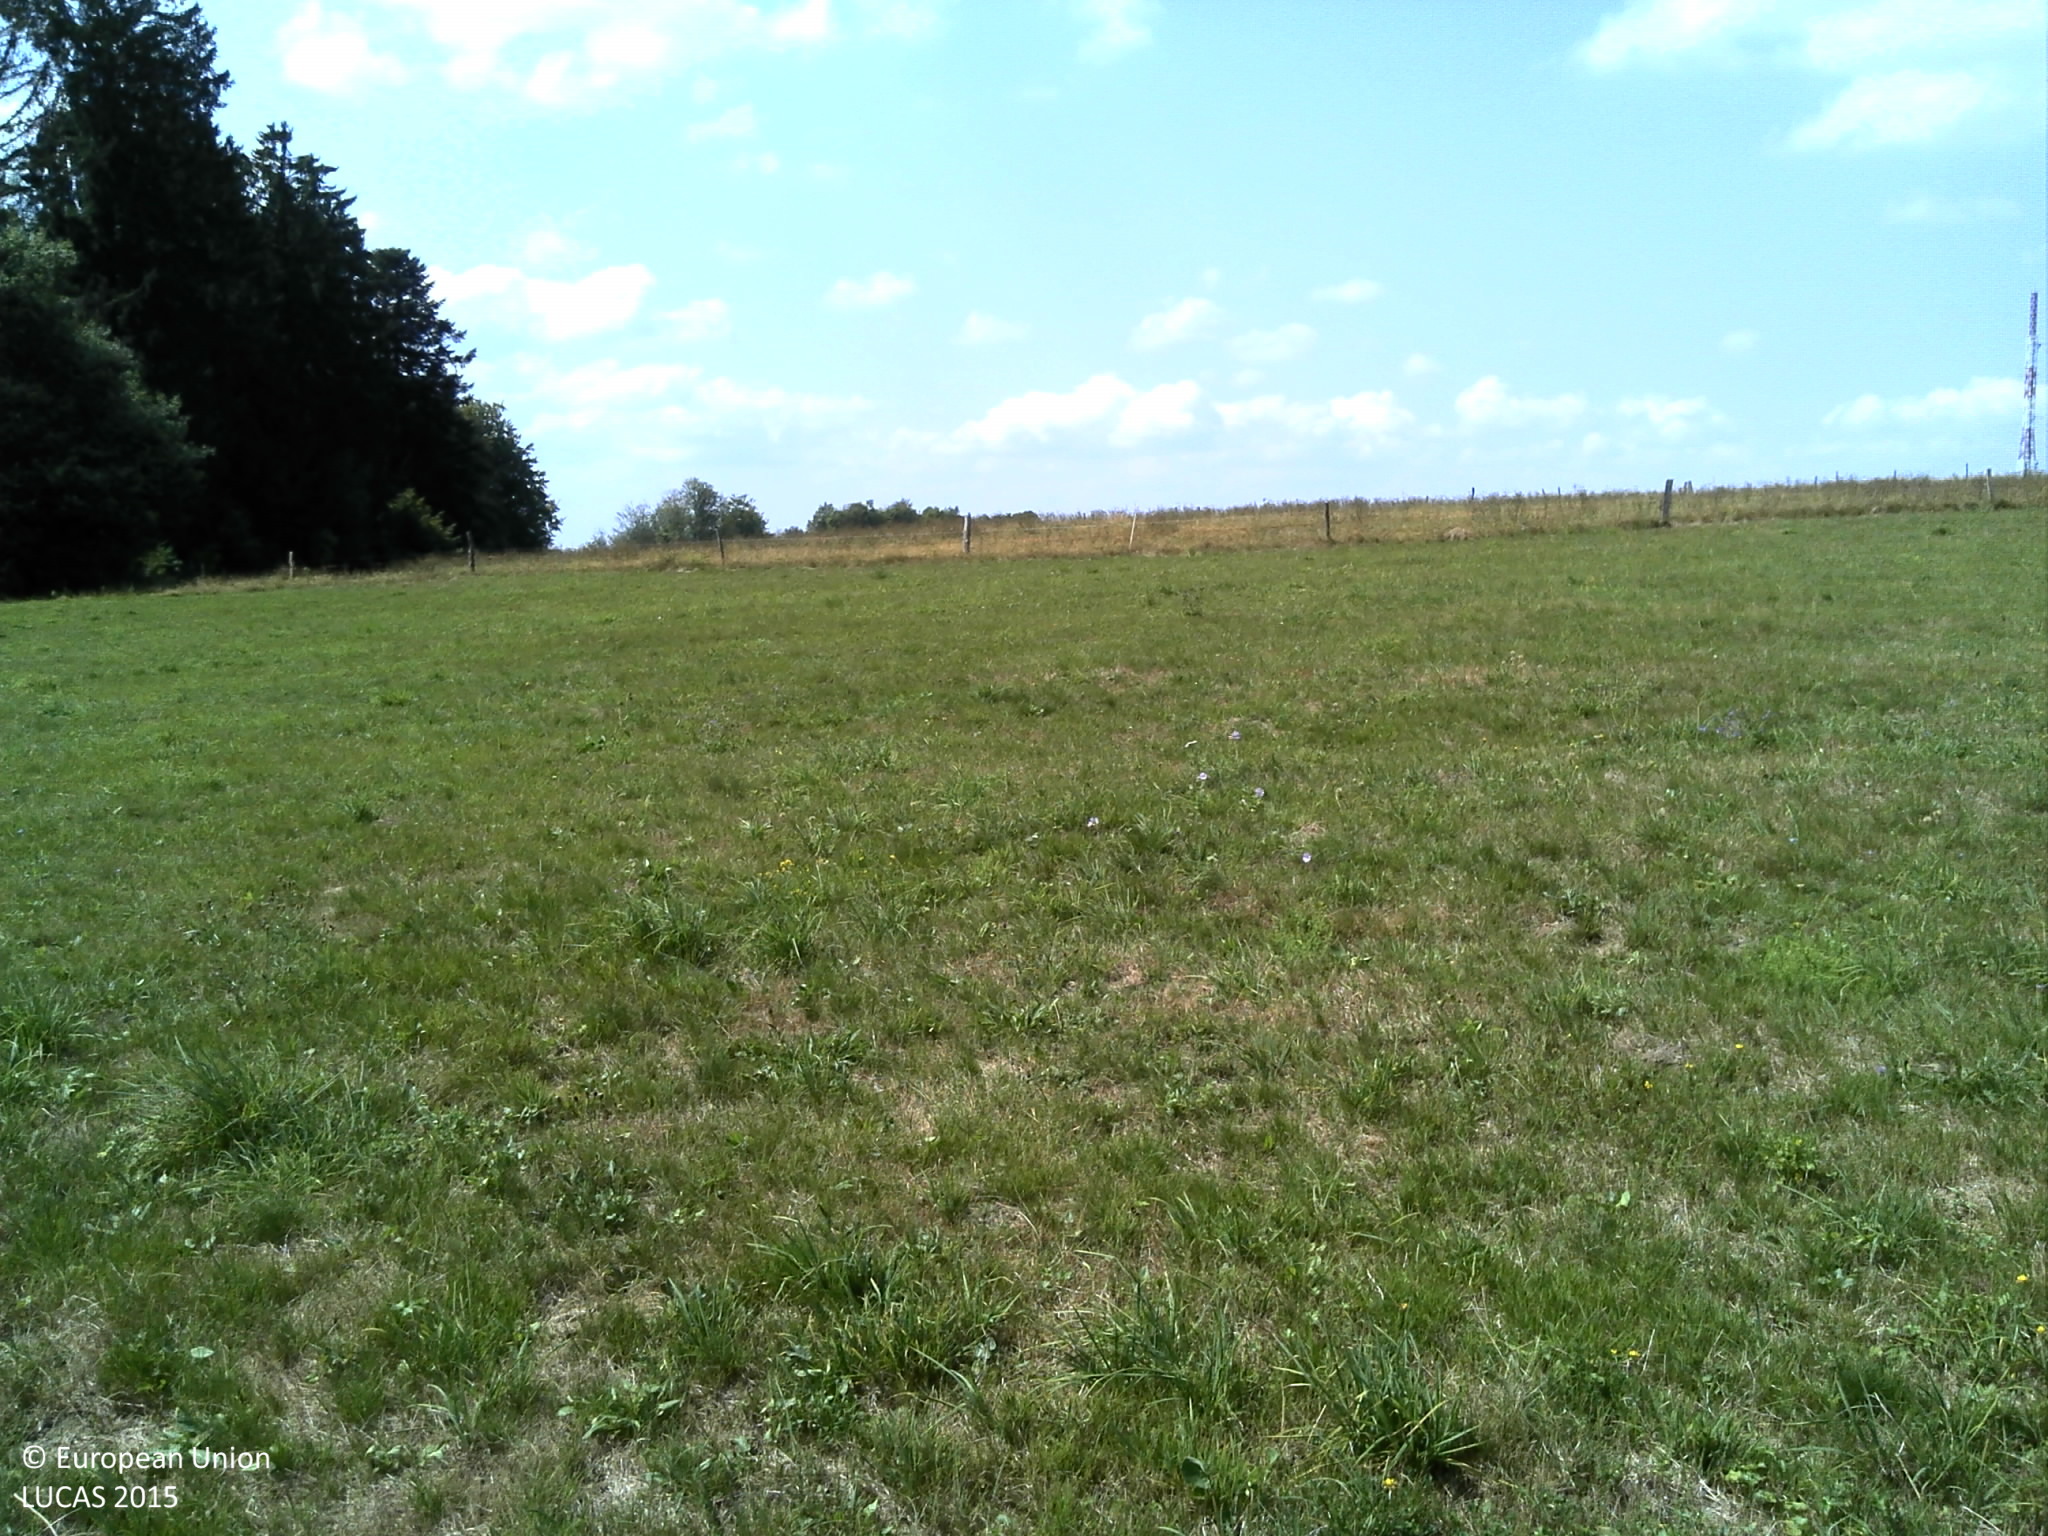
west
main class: Grassland
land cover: Grassland without tree/shrub cover
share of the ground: > 75 %
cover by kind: herbaceous plants 100 %
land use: Agriculture (excluding fallow land and kitchen gardens)
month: August
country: FR
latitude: 48.0008
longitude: 6.3419
